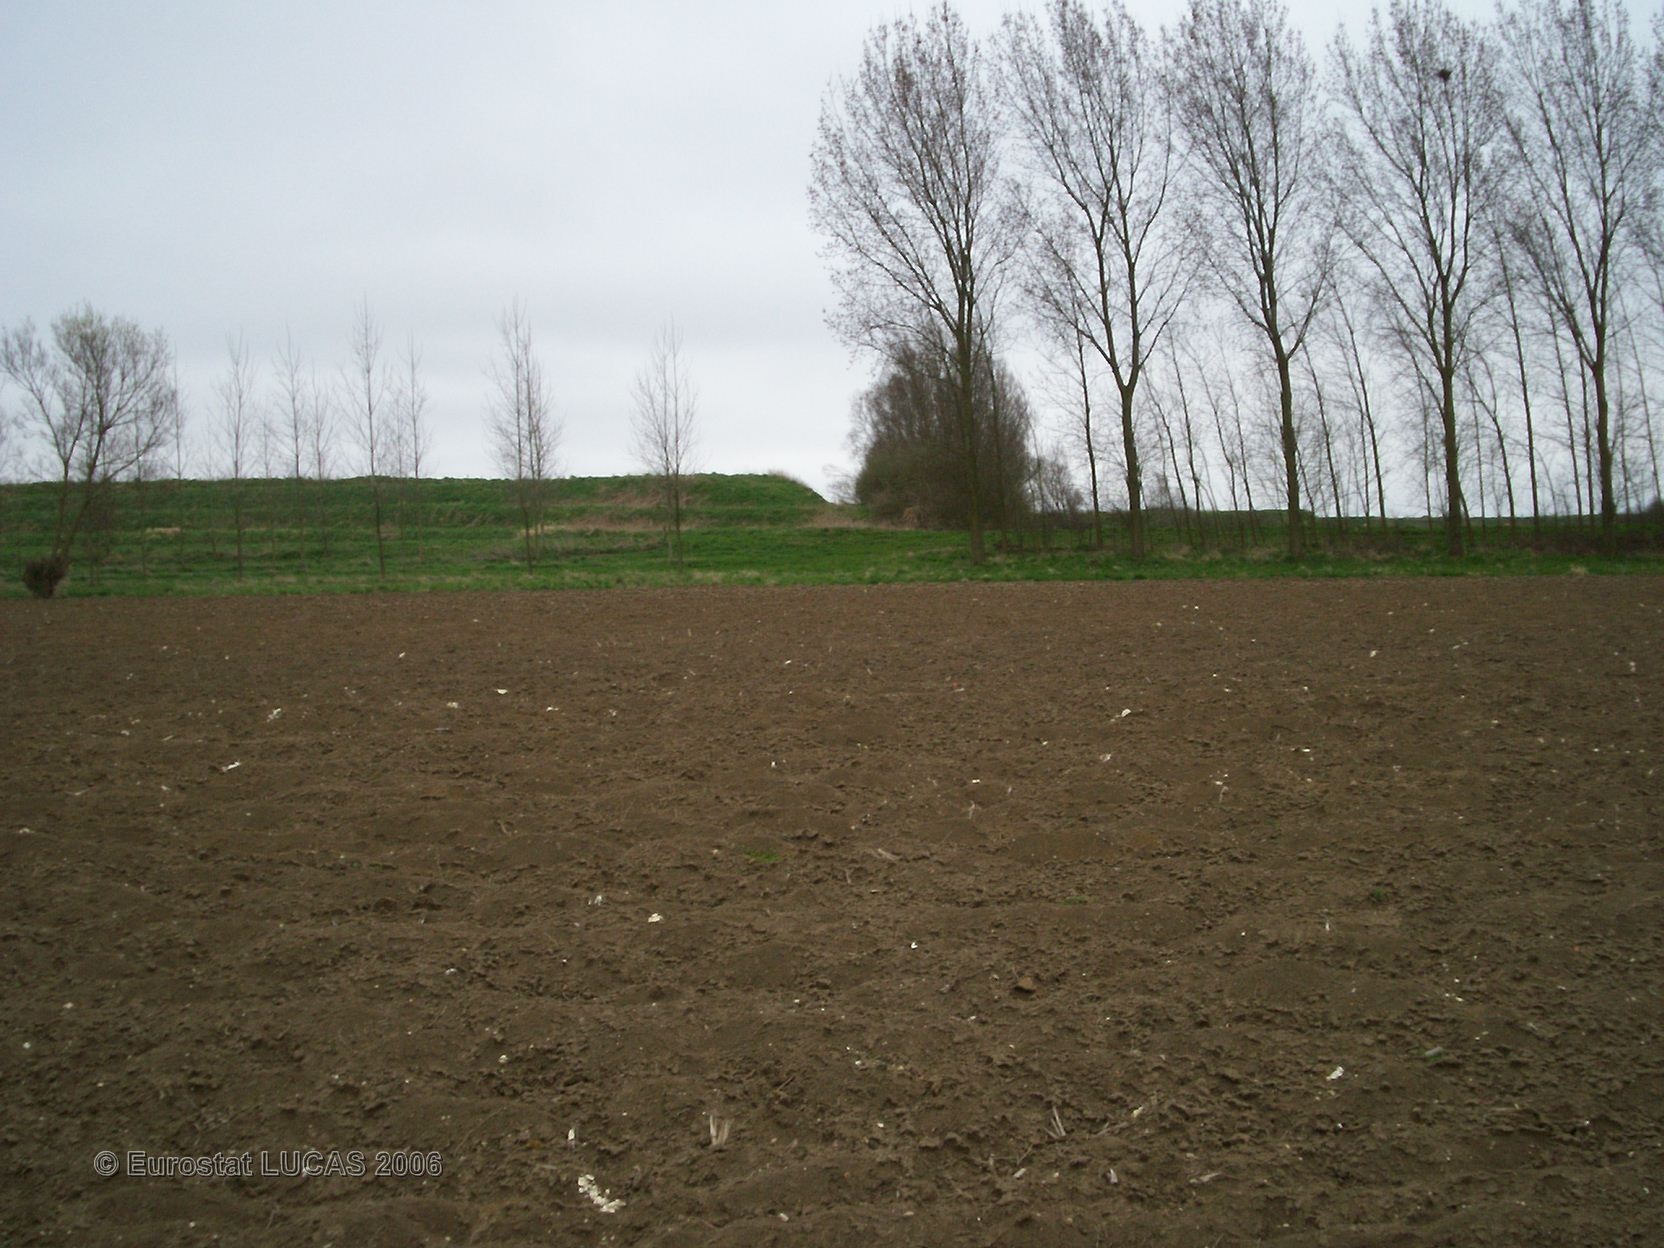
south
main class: Cropland
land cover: Maize
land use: Agriculture (excluding fallow land and kitchen gardens)
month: May
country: FR
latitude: 50.5703
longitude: 2.5183
